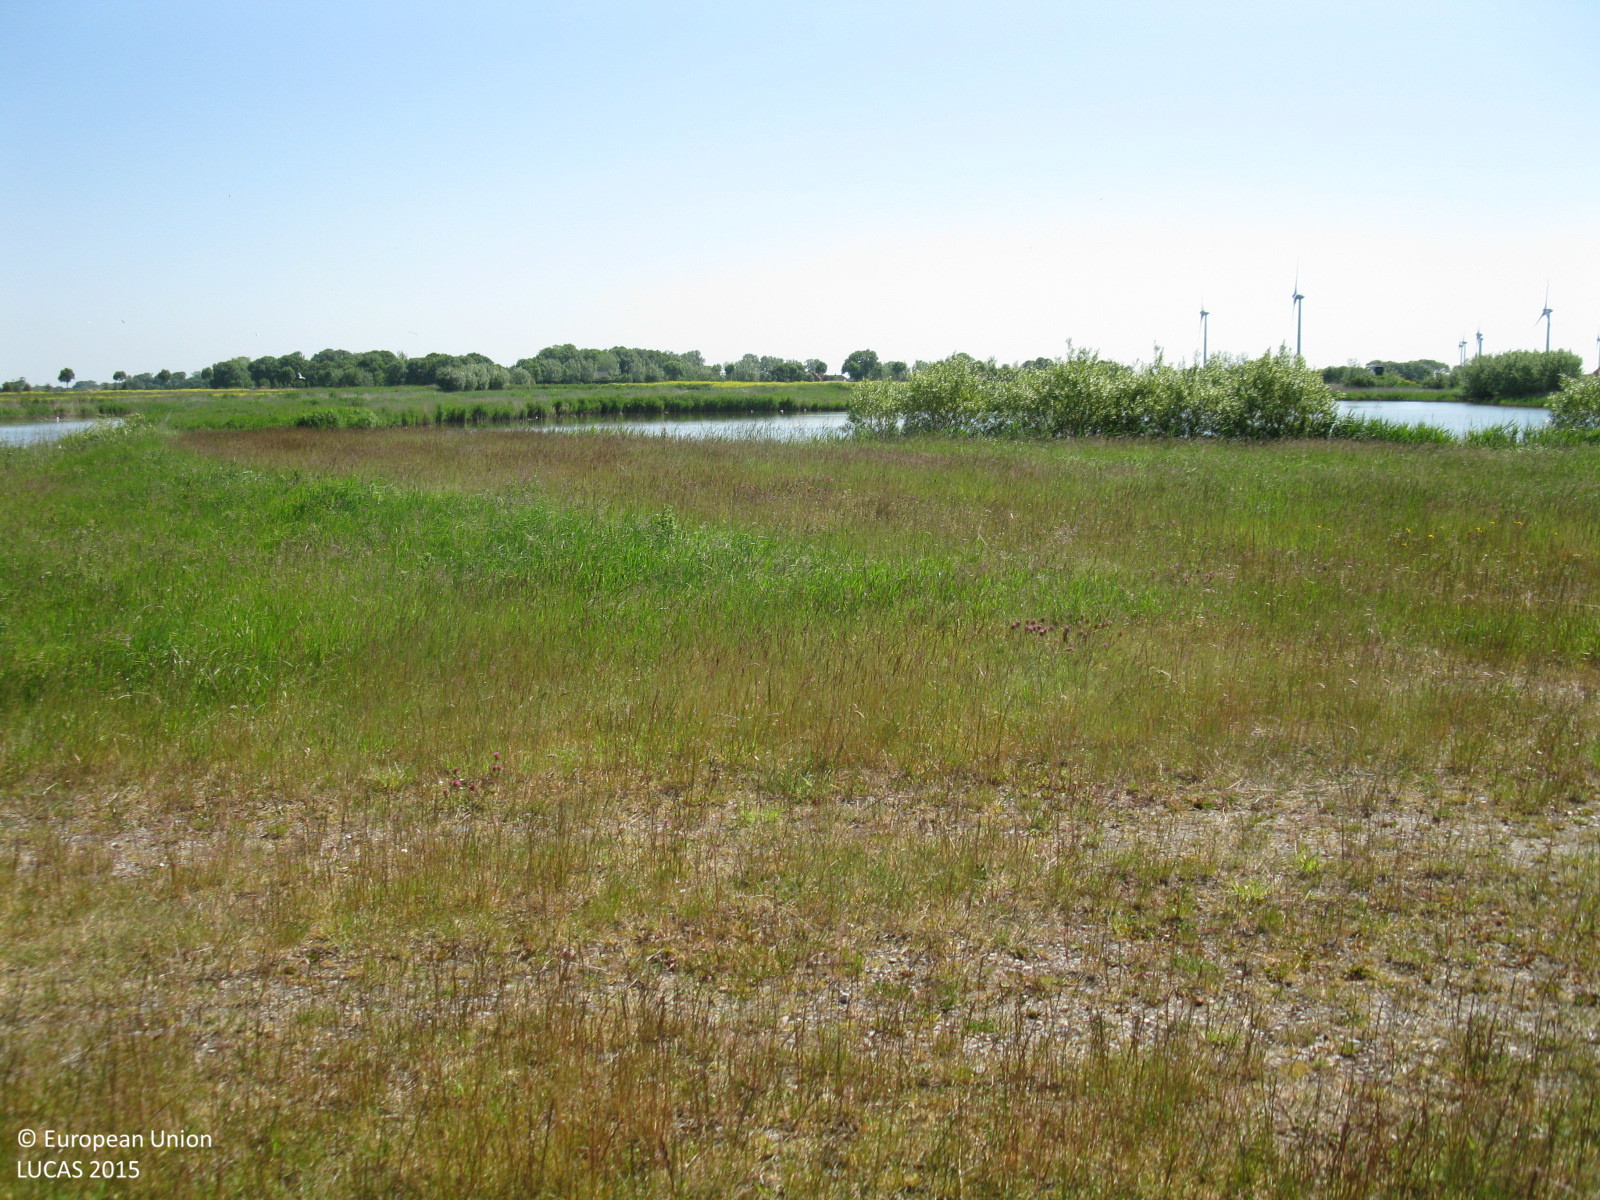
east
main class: Grassland
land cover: Grassland without tree/shrub cover
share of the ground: > 75 %
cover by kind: herbaceous plants 100 %
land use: Agriculture (excluding fallow land and kitchen gardens)
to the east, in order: Grassland without tree/shrub cover; Tracks; Grassland without tree/shrub cover; Inland fresh water bodies; Grassland without tree/shrub cover; Inland fresh water bodies
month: June
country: DE
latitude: 53.4982
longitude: 8.3274
